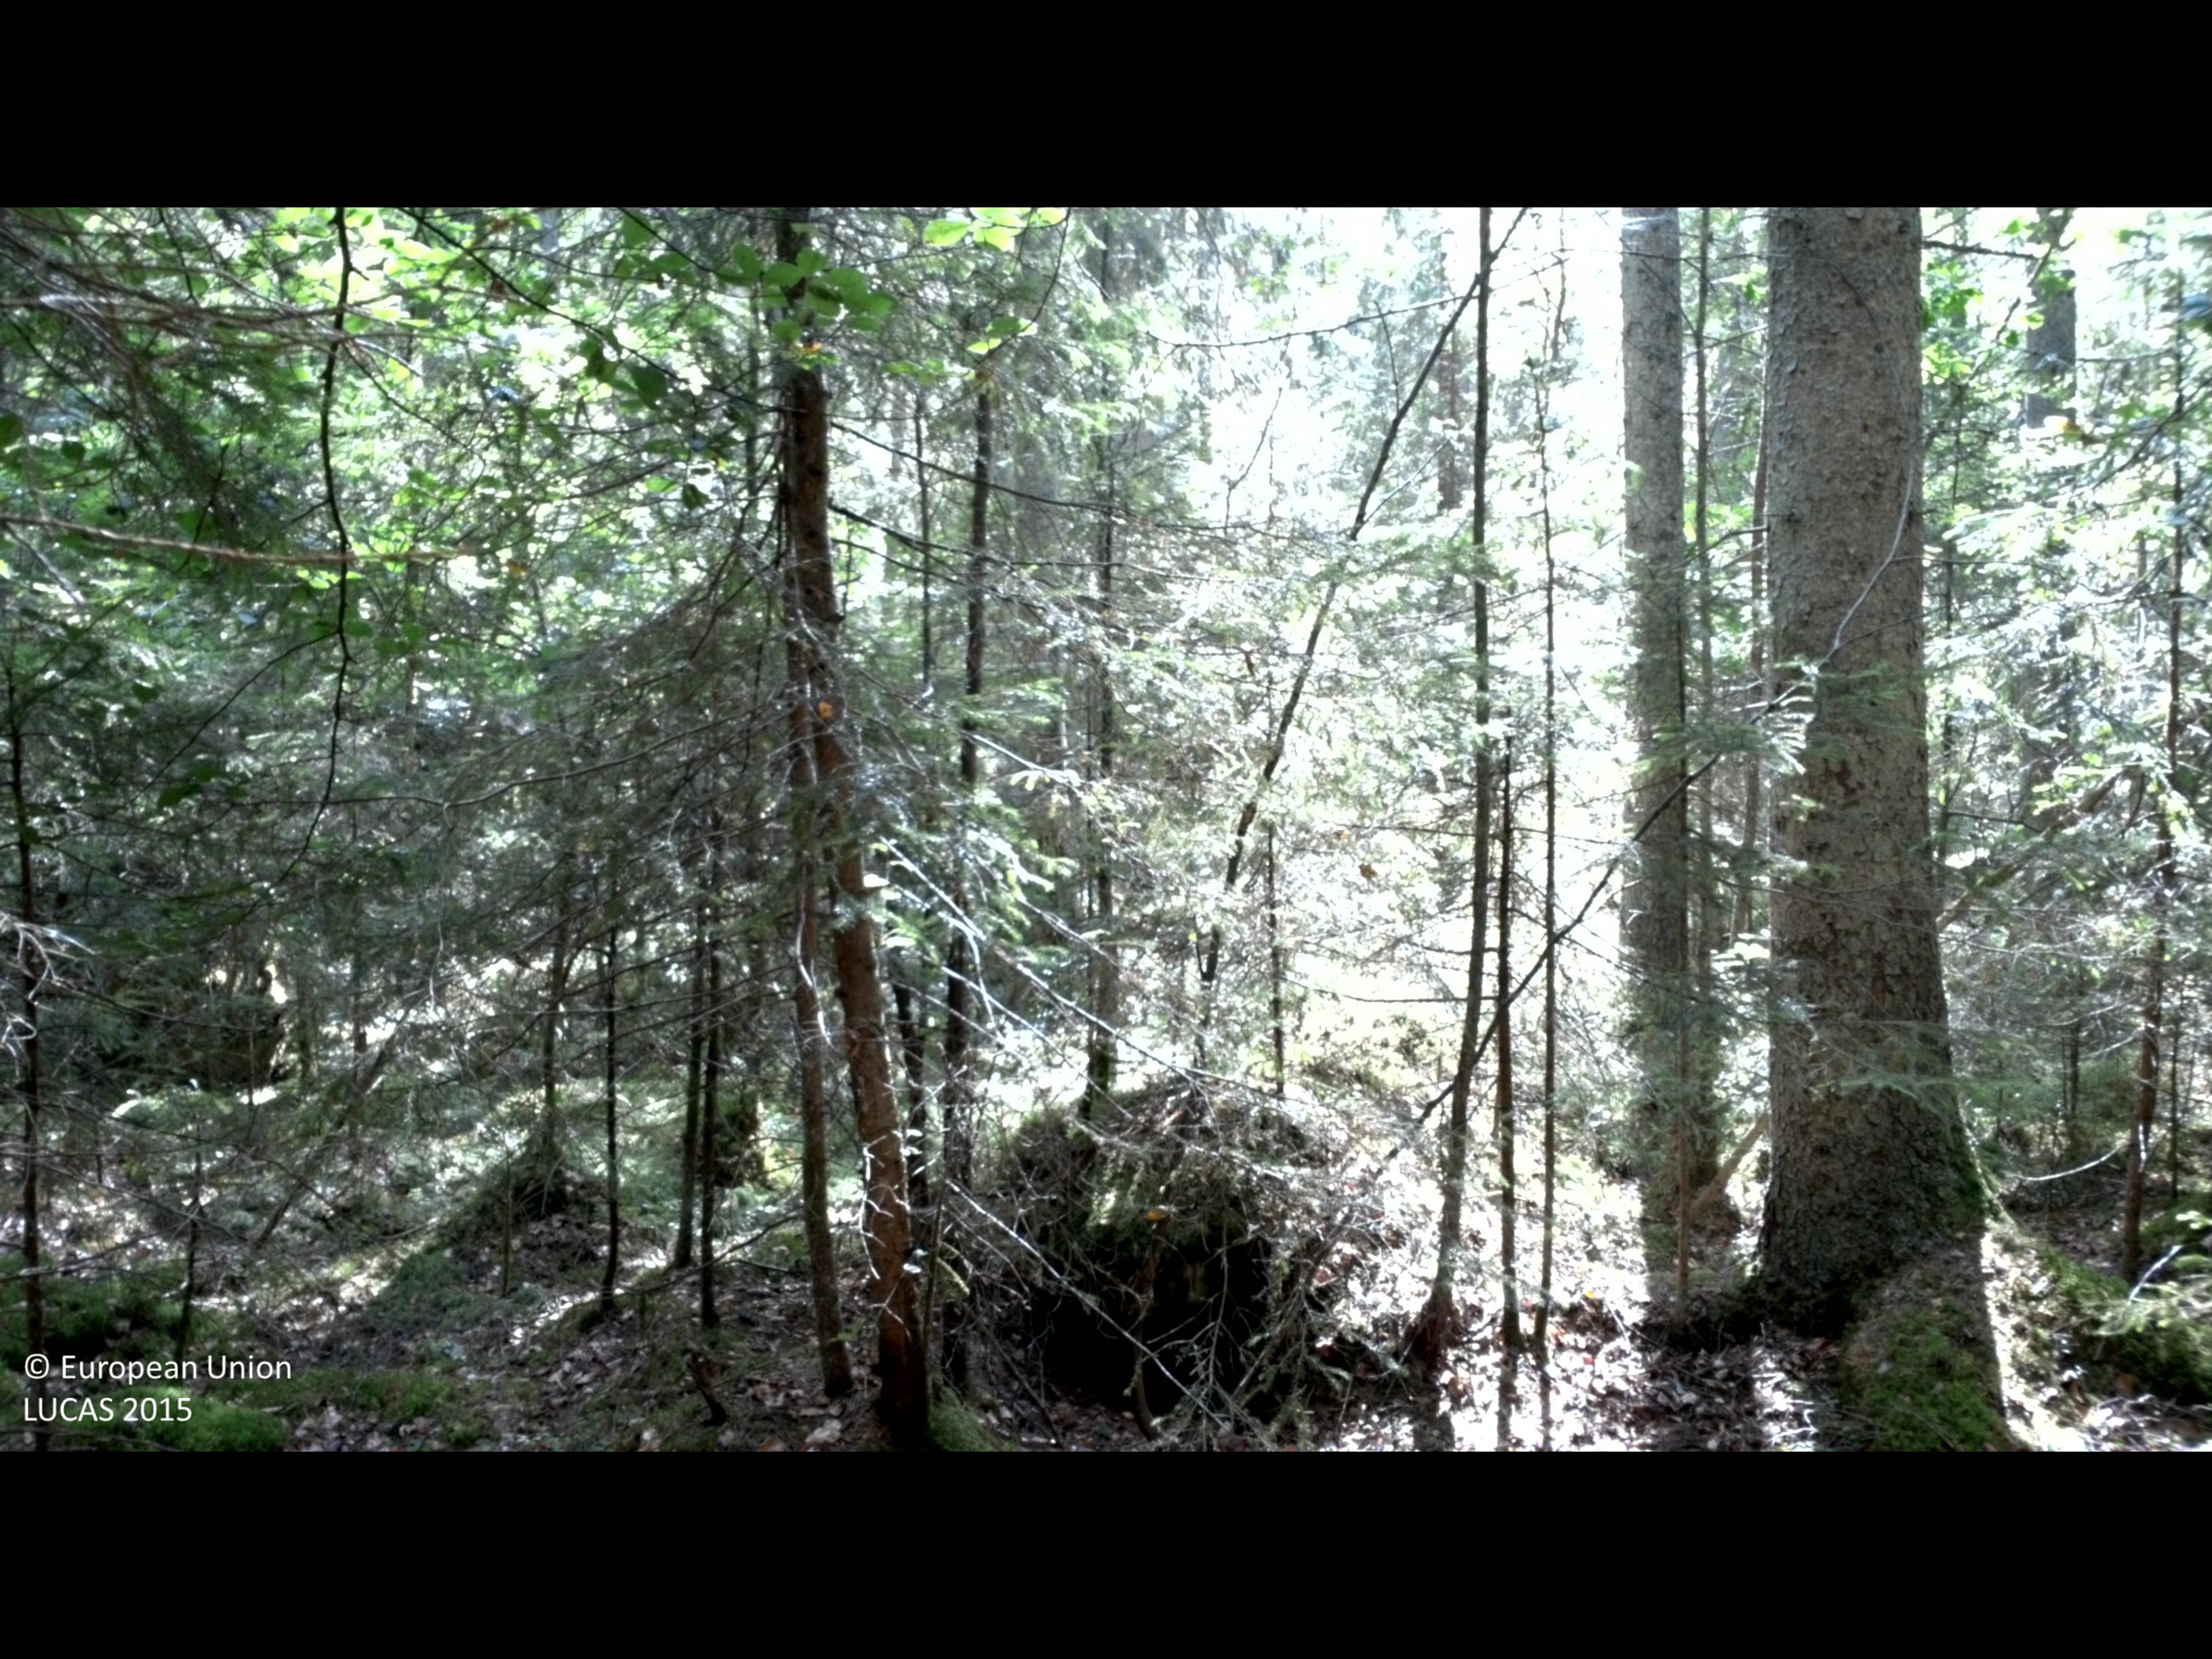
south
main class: Woodland
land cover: Spruce dominated coniferous woodland
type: boreal forest
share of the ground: > 75 %
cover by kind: coniferous forest trees 70 %, broadleaved forest trees 15 %, shrubs 5 %, herbaceous plants 5 %, lichens and mosses 5 %
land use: Forestry
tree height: > 5 m
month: August
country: SE
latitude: 56.2784
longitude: 14.7951
